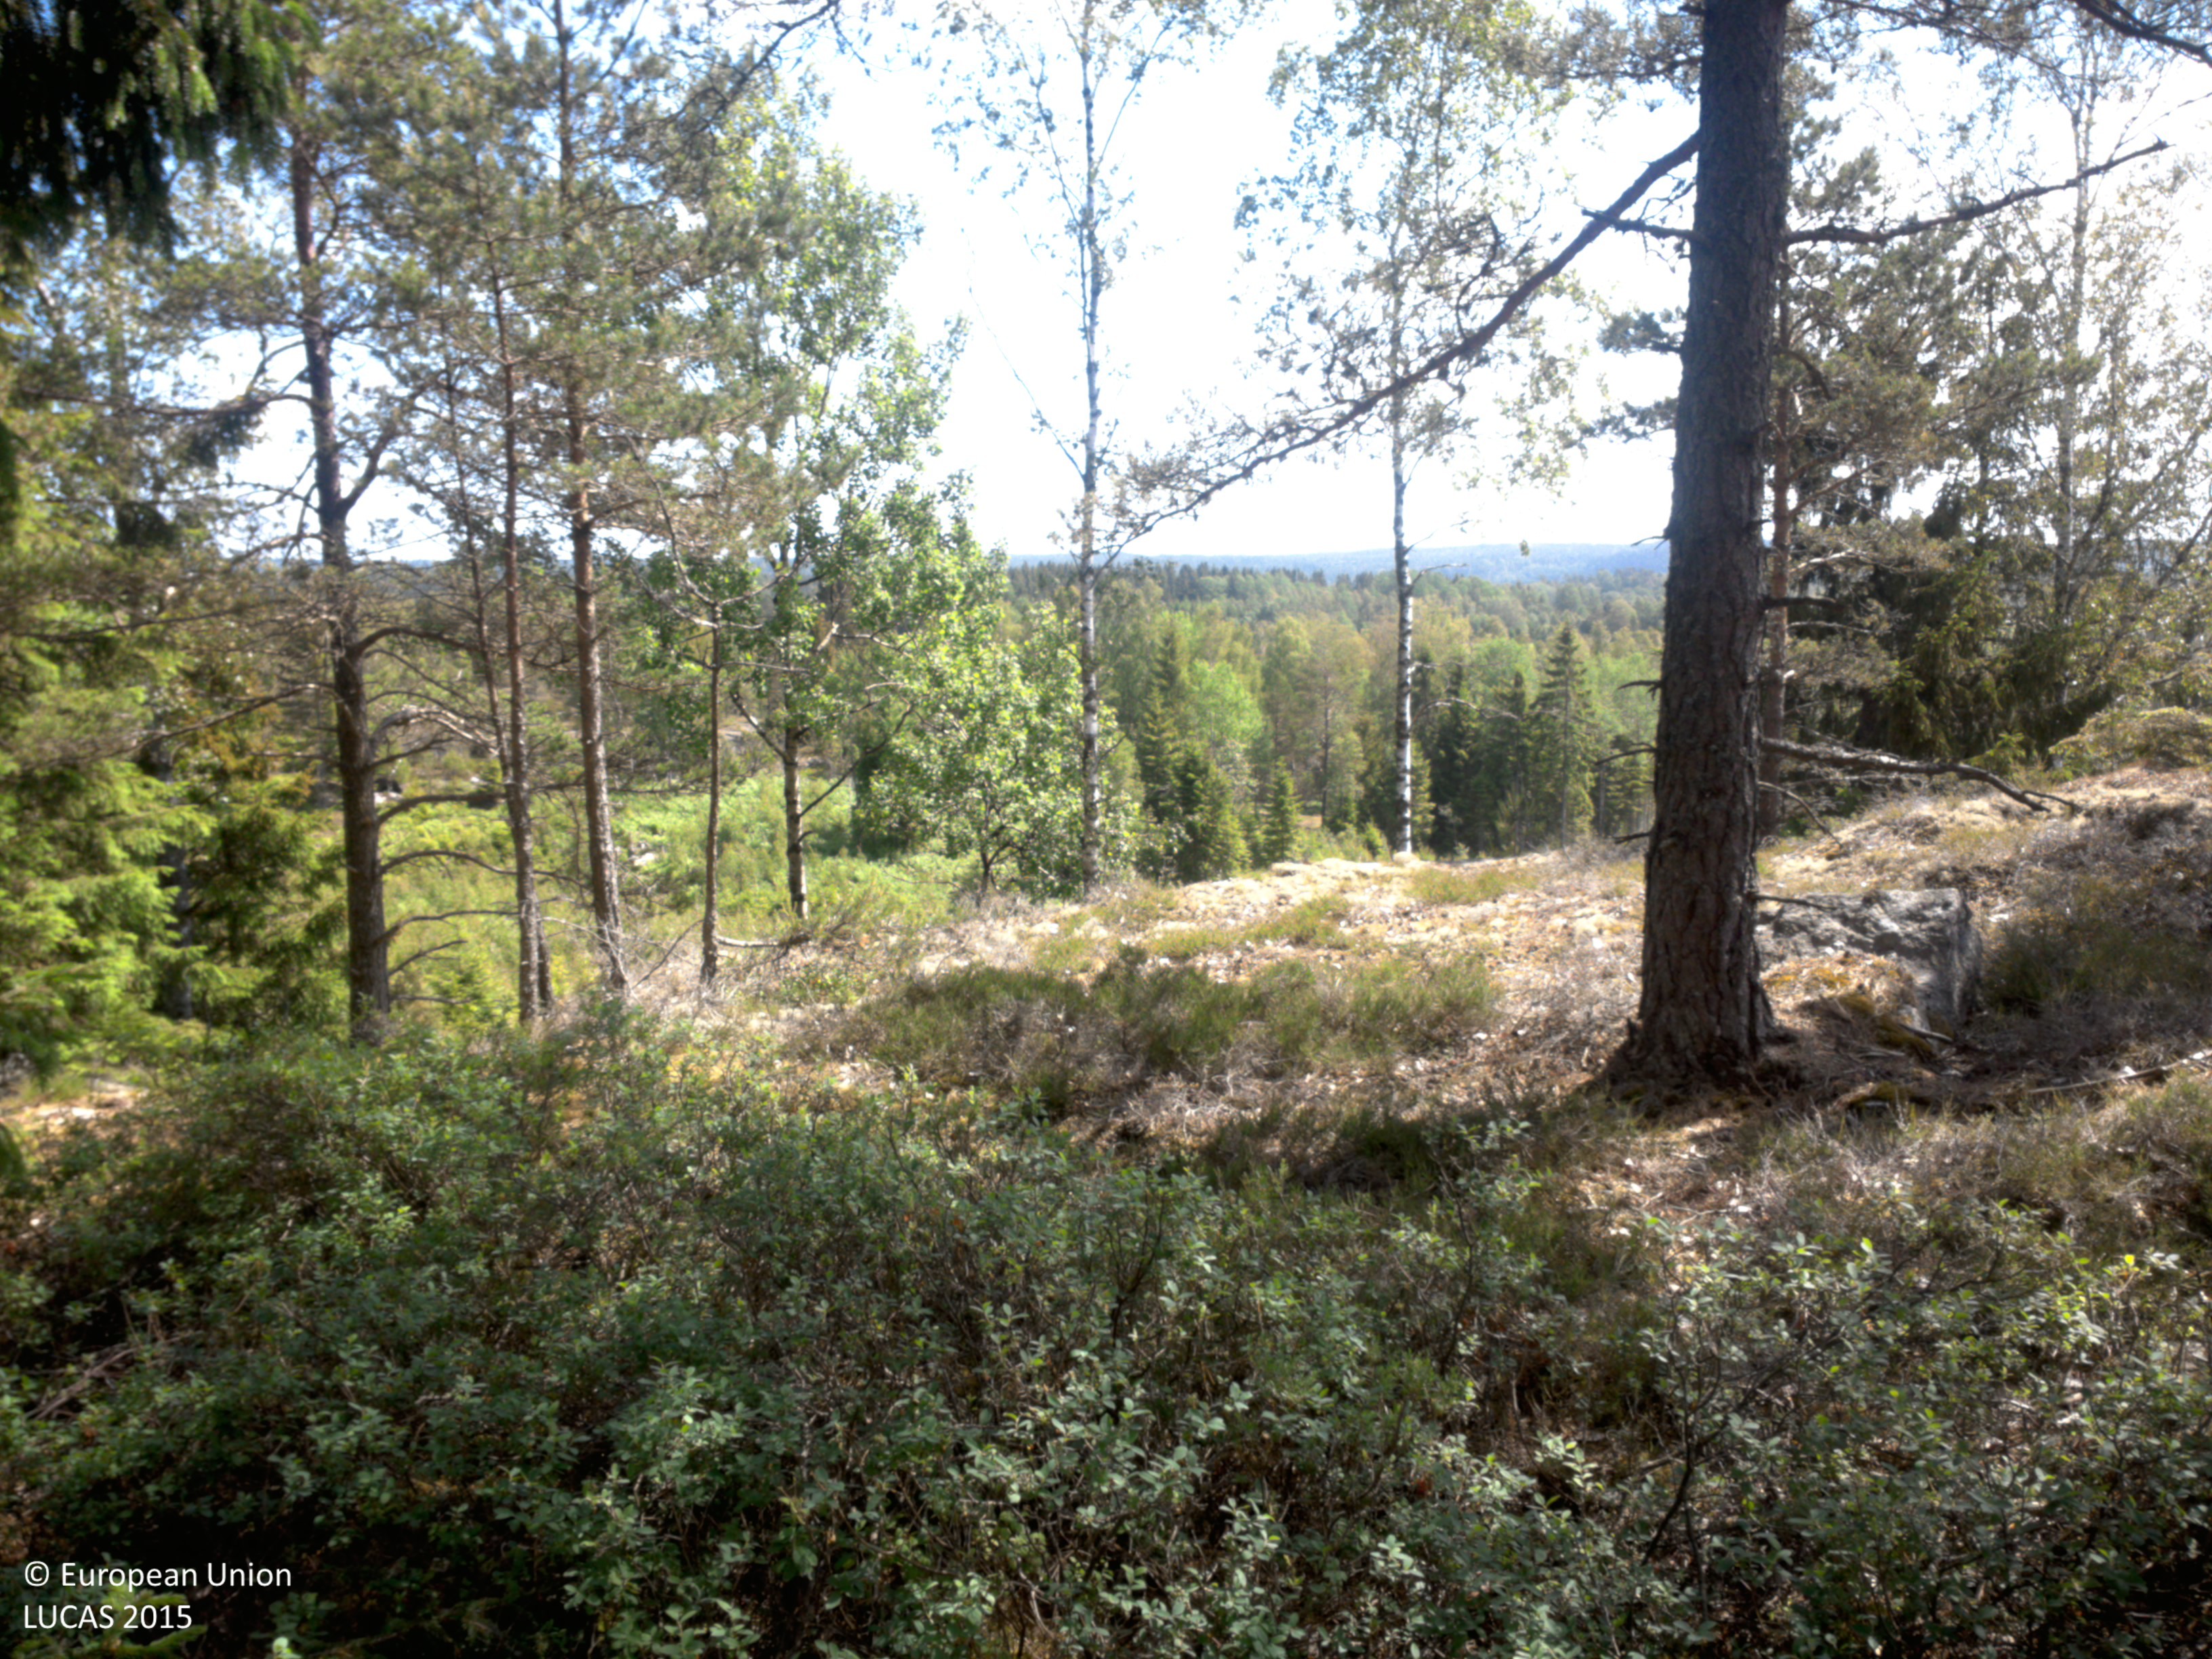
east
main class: Woodland
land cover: Pine dominated mixed woodland
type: boreal forest
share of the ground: 25 - 50 %
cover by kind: coniferous forest trees 30 %, lichens and mosses 20 %, broadleaved forest trees 15 %, consolidated bare surface 15 %, shrubs 10 %, herbaceous plants 10 %
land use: Forestry
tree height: > 5 m
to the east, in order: Pine dominated mixed woodland; Rock outcrops; Pine dominated mixed woodland; Broadleaved woodland; Tracks; Spruce dominated mixed woodland; Pine dominated mixed woodland; Ditches and canals; Grass margins; Tracks; Ditches and canals; Broadleaved woodland
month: June
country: SE
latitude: 58.6605
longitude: 11.5308
